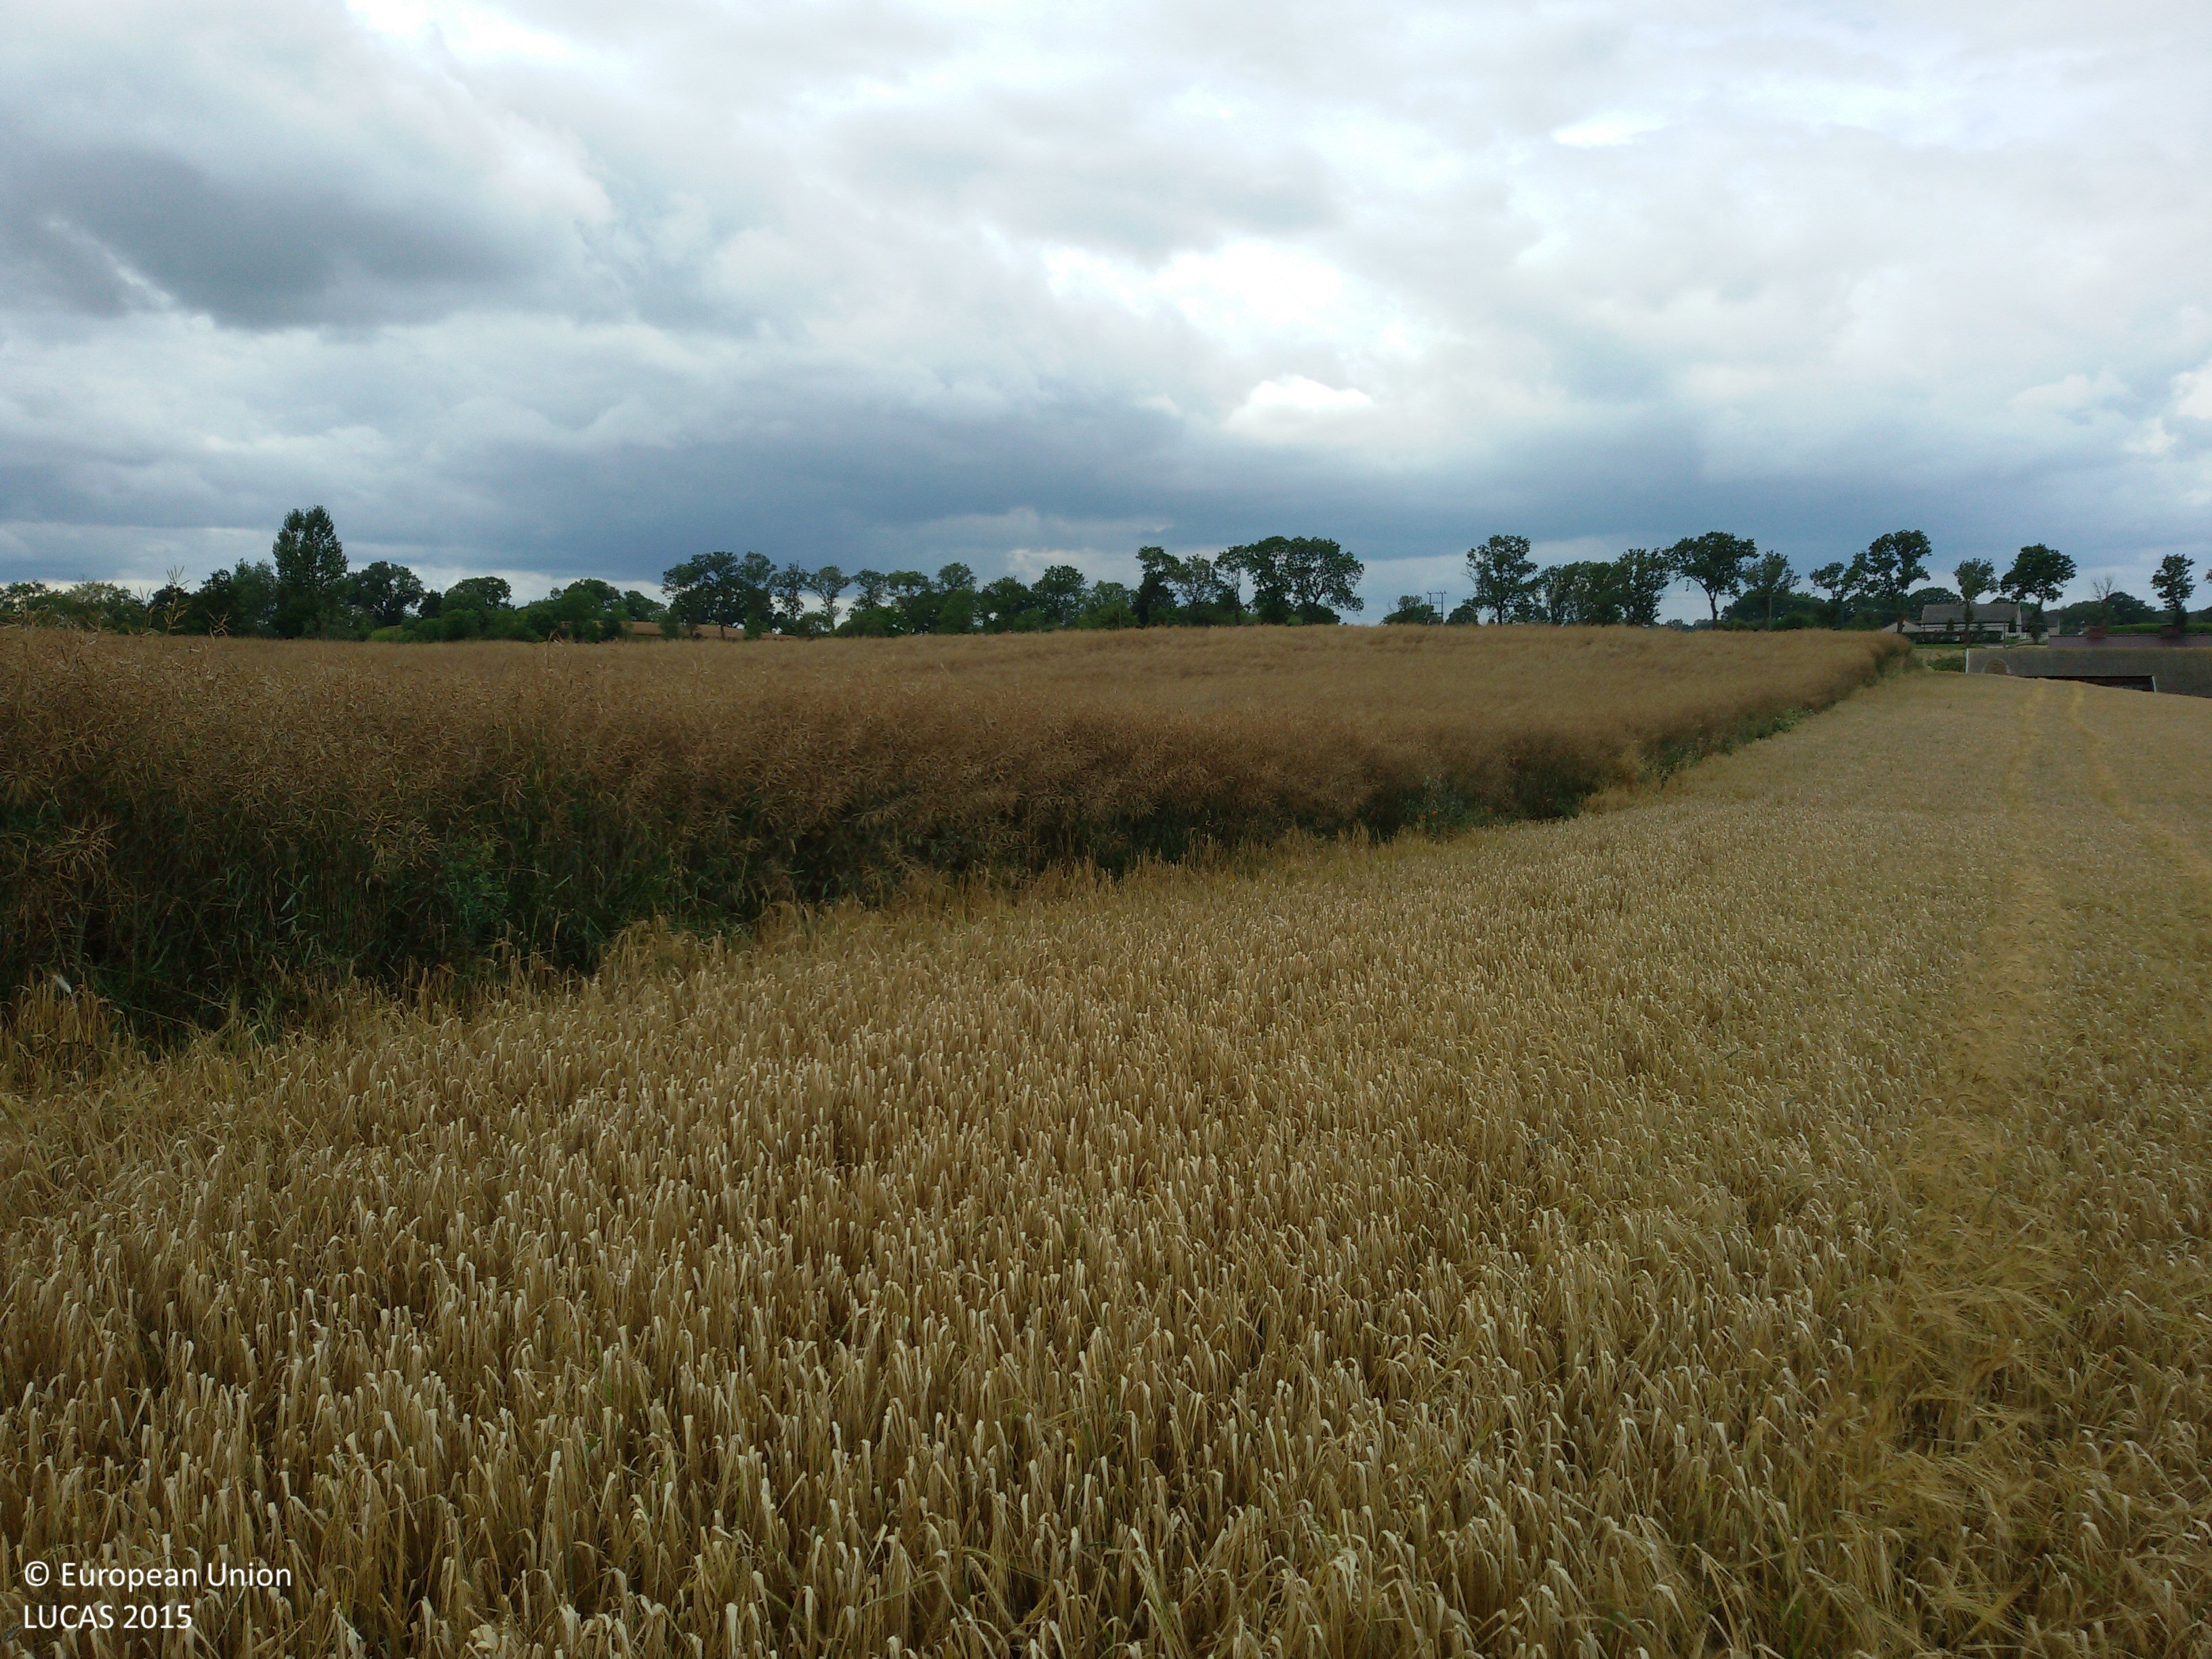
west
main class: Cropland
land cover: Barley
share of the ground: > 75 %
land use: Agriculture (excluding fallow land and kitchen gardens)
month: July
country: PL
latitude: 52.9845
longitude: 19.1248
